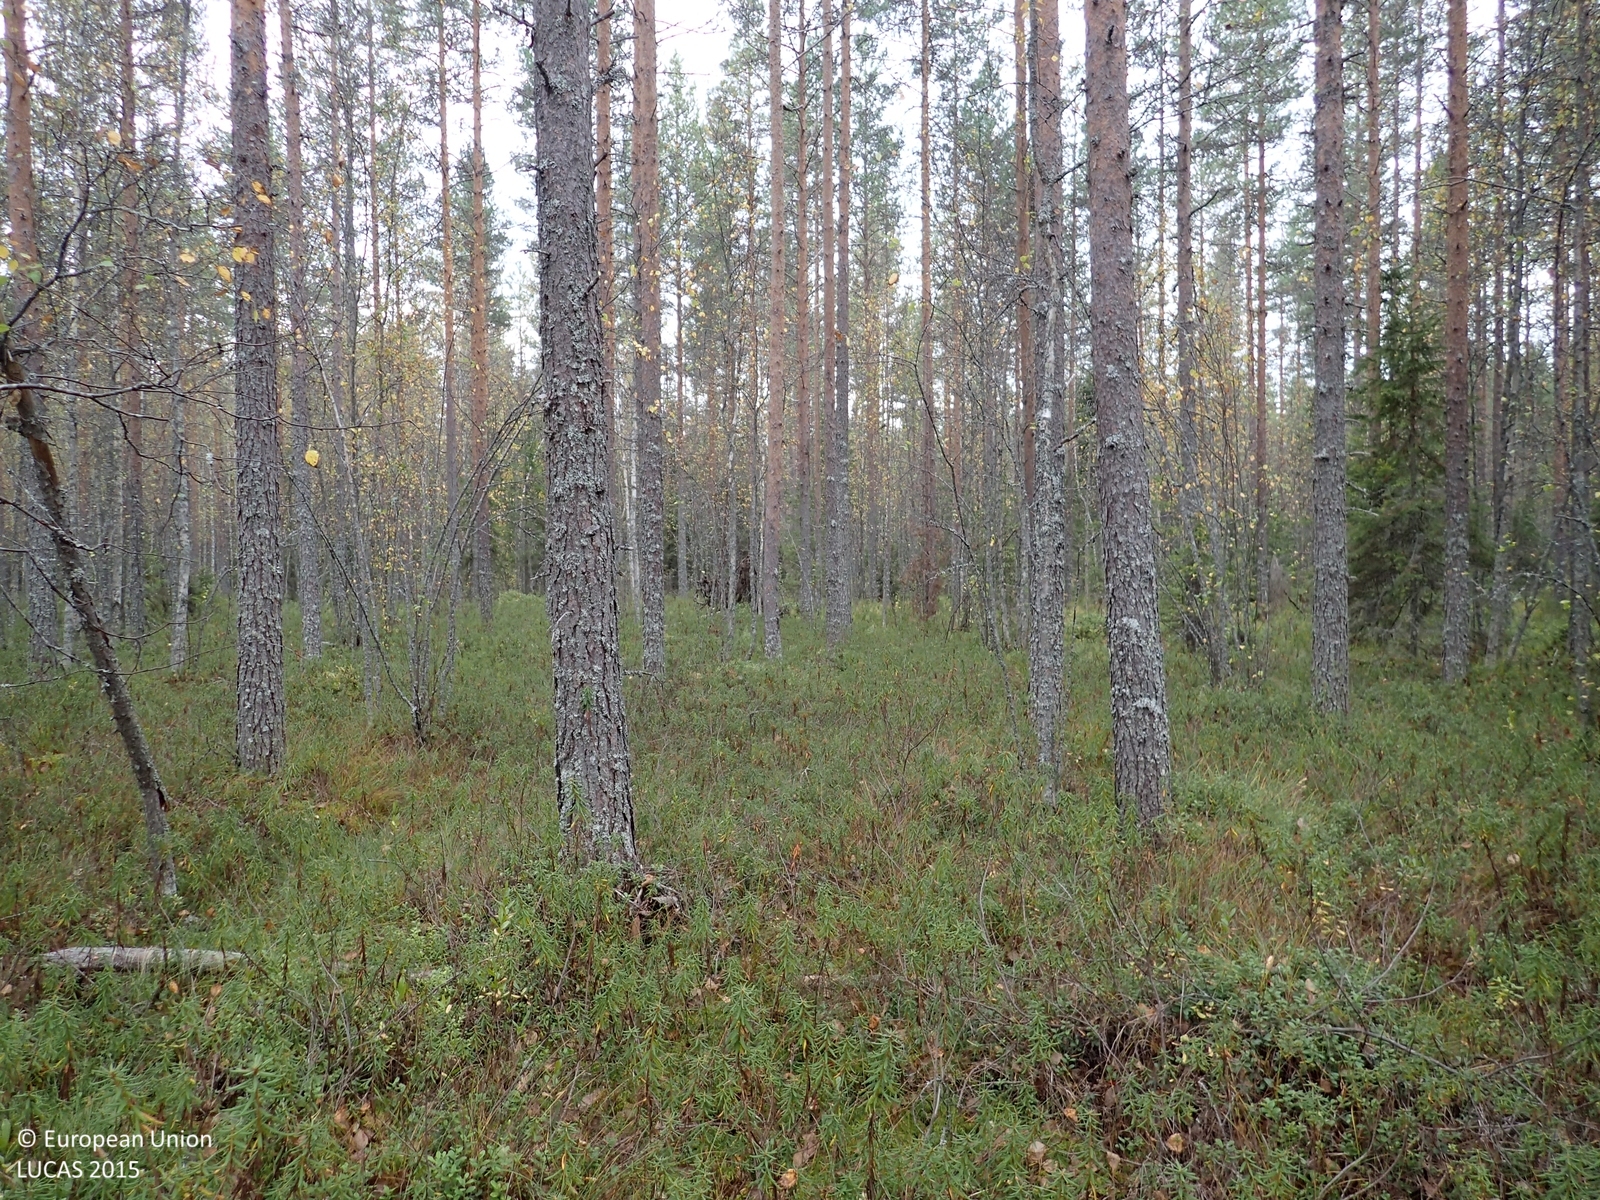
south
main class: Woodland
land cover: Pine dominated mixed woodland
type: mire and swamp forests
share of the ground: > 75 %
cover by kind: coniferous forest trees 55 %, shrubs 25 %, broadleaved forest trees 20 %
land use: Forestry
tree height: > 5 m
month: September
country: FI
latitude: 63.3225
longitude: 25.2503
